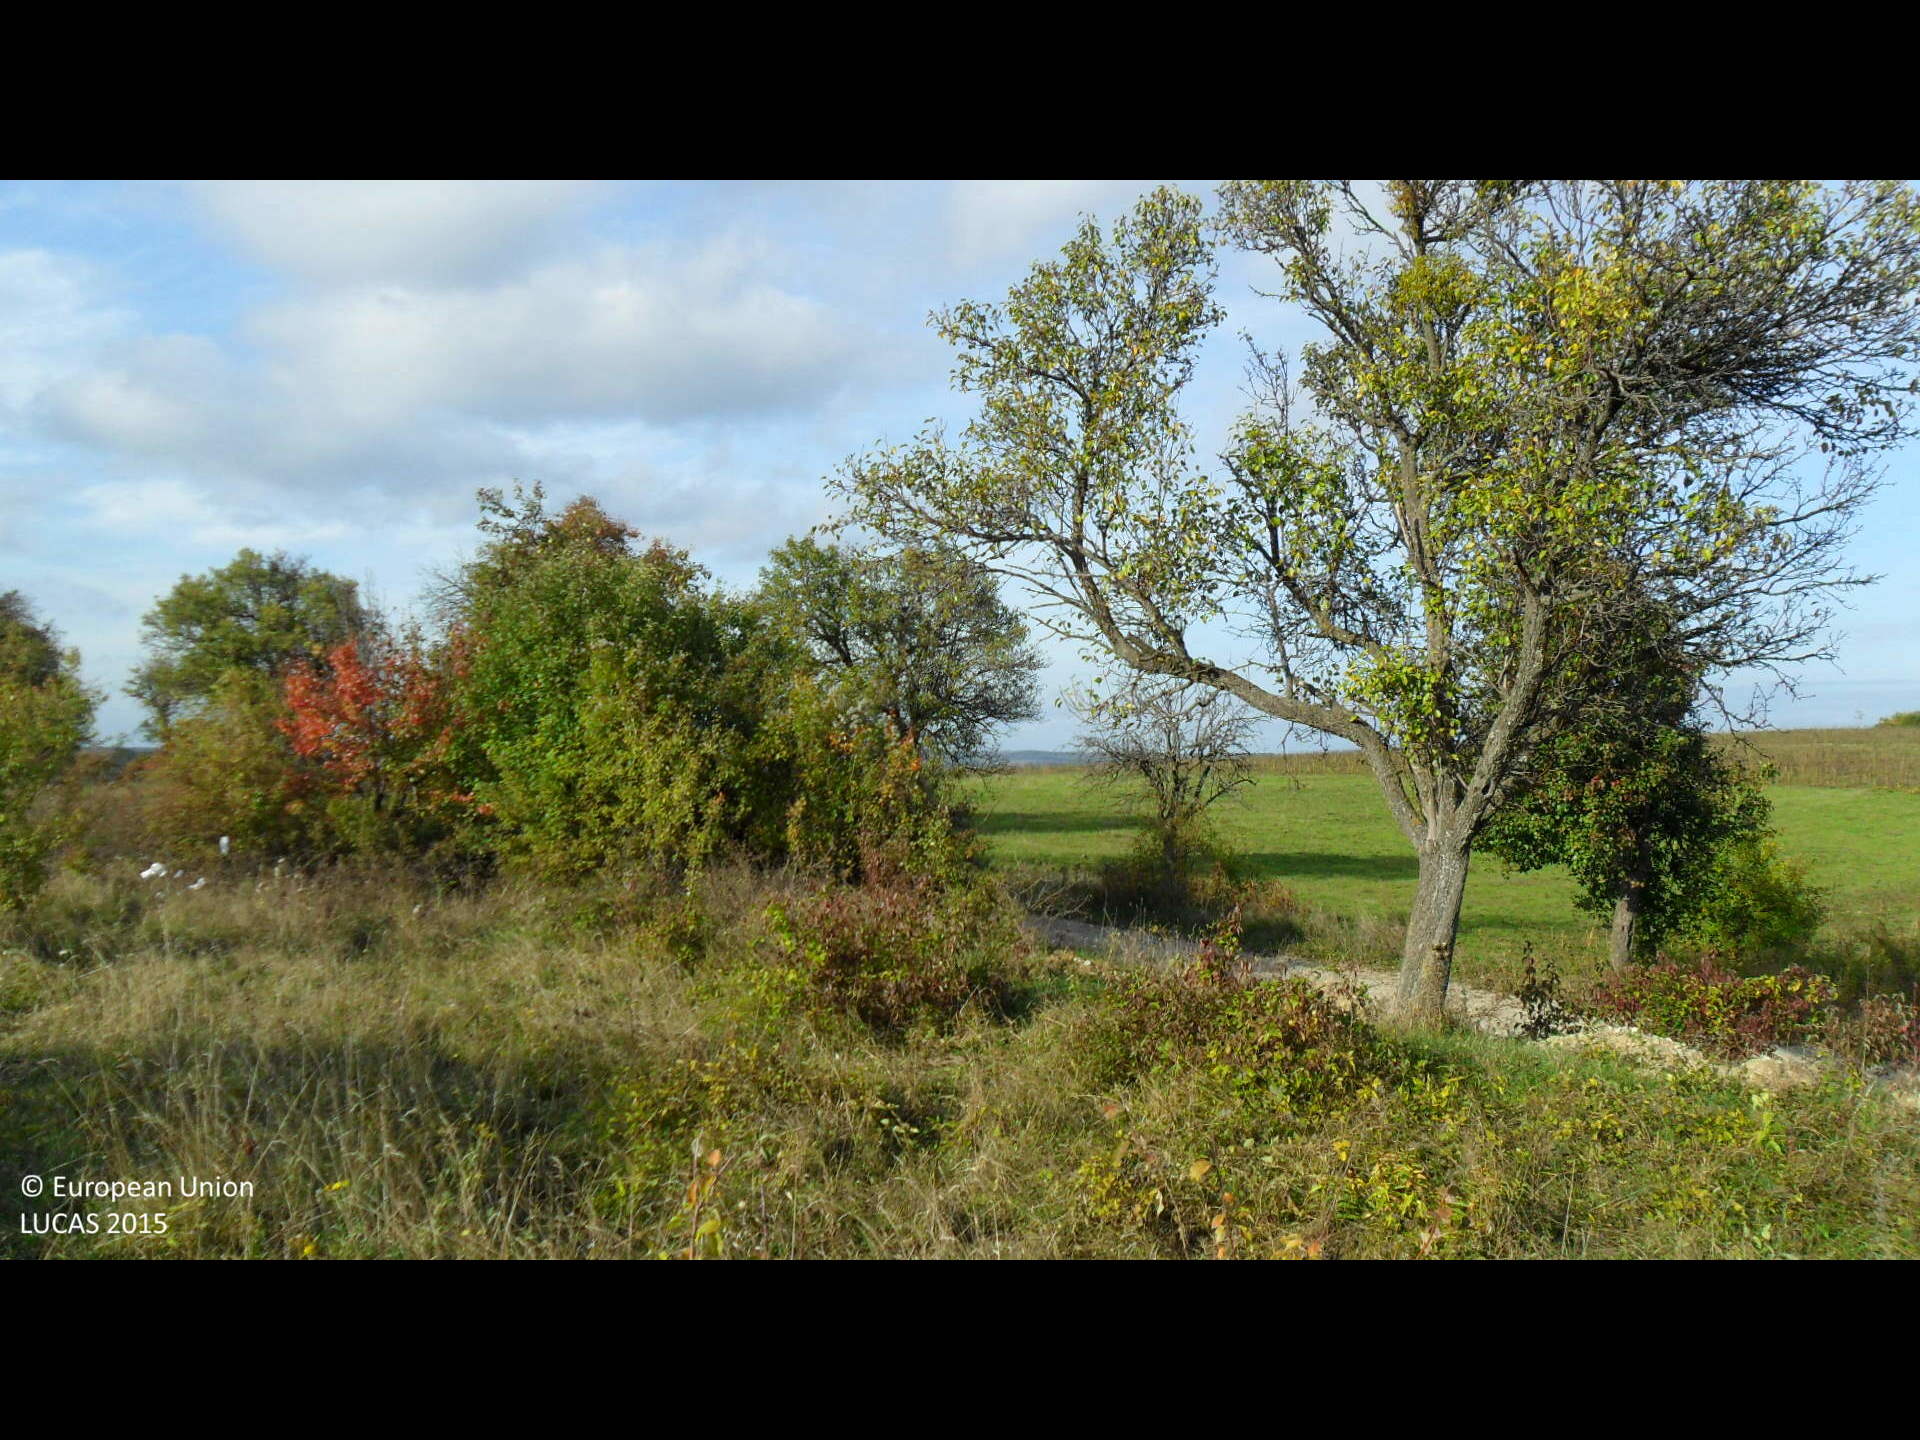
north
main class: Grassland
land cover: Grassland with sparse tree/shrub cover
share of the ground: > 75 %
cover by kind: herbaceous plants 90 %, broadleaved forest trees 5 %, shrubs 5 %
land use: Agriculture (excluding fallow land and kitchen gardens)
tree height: < 5 m
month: October
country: BG
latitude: 43.0725
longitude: 26.1677
